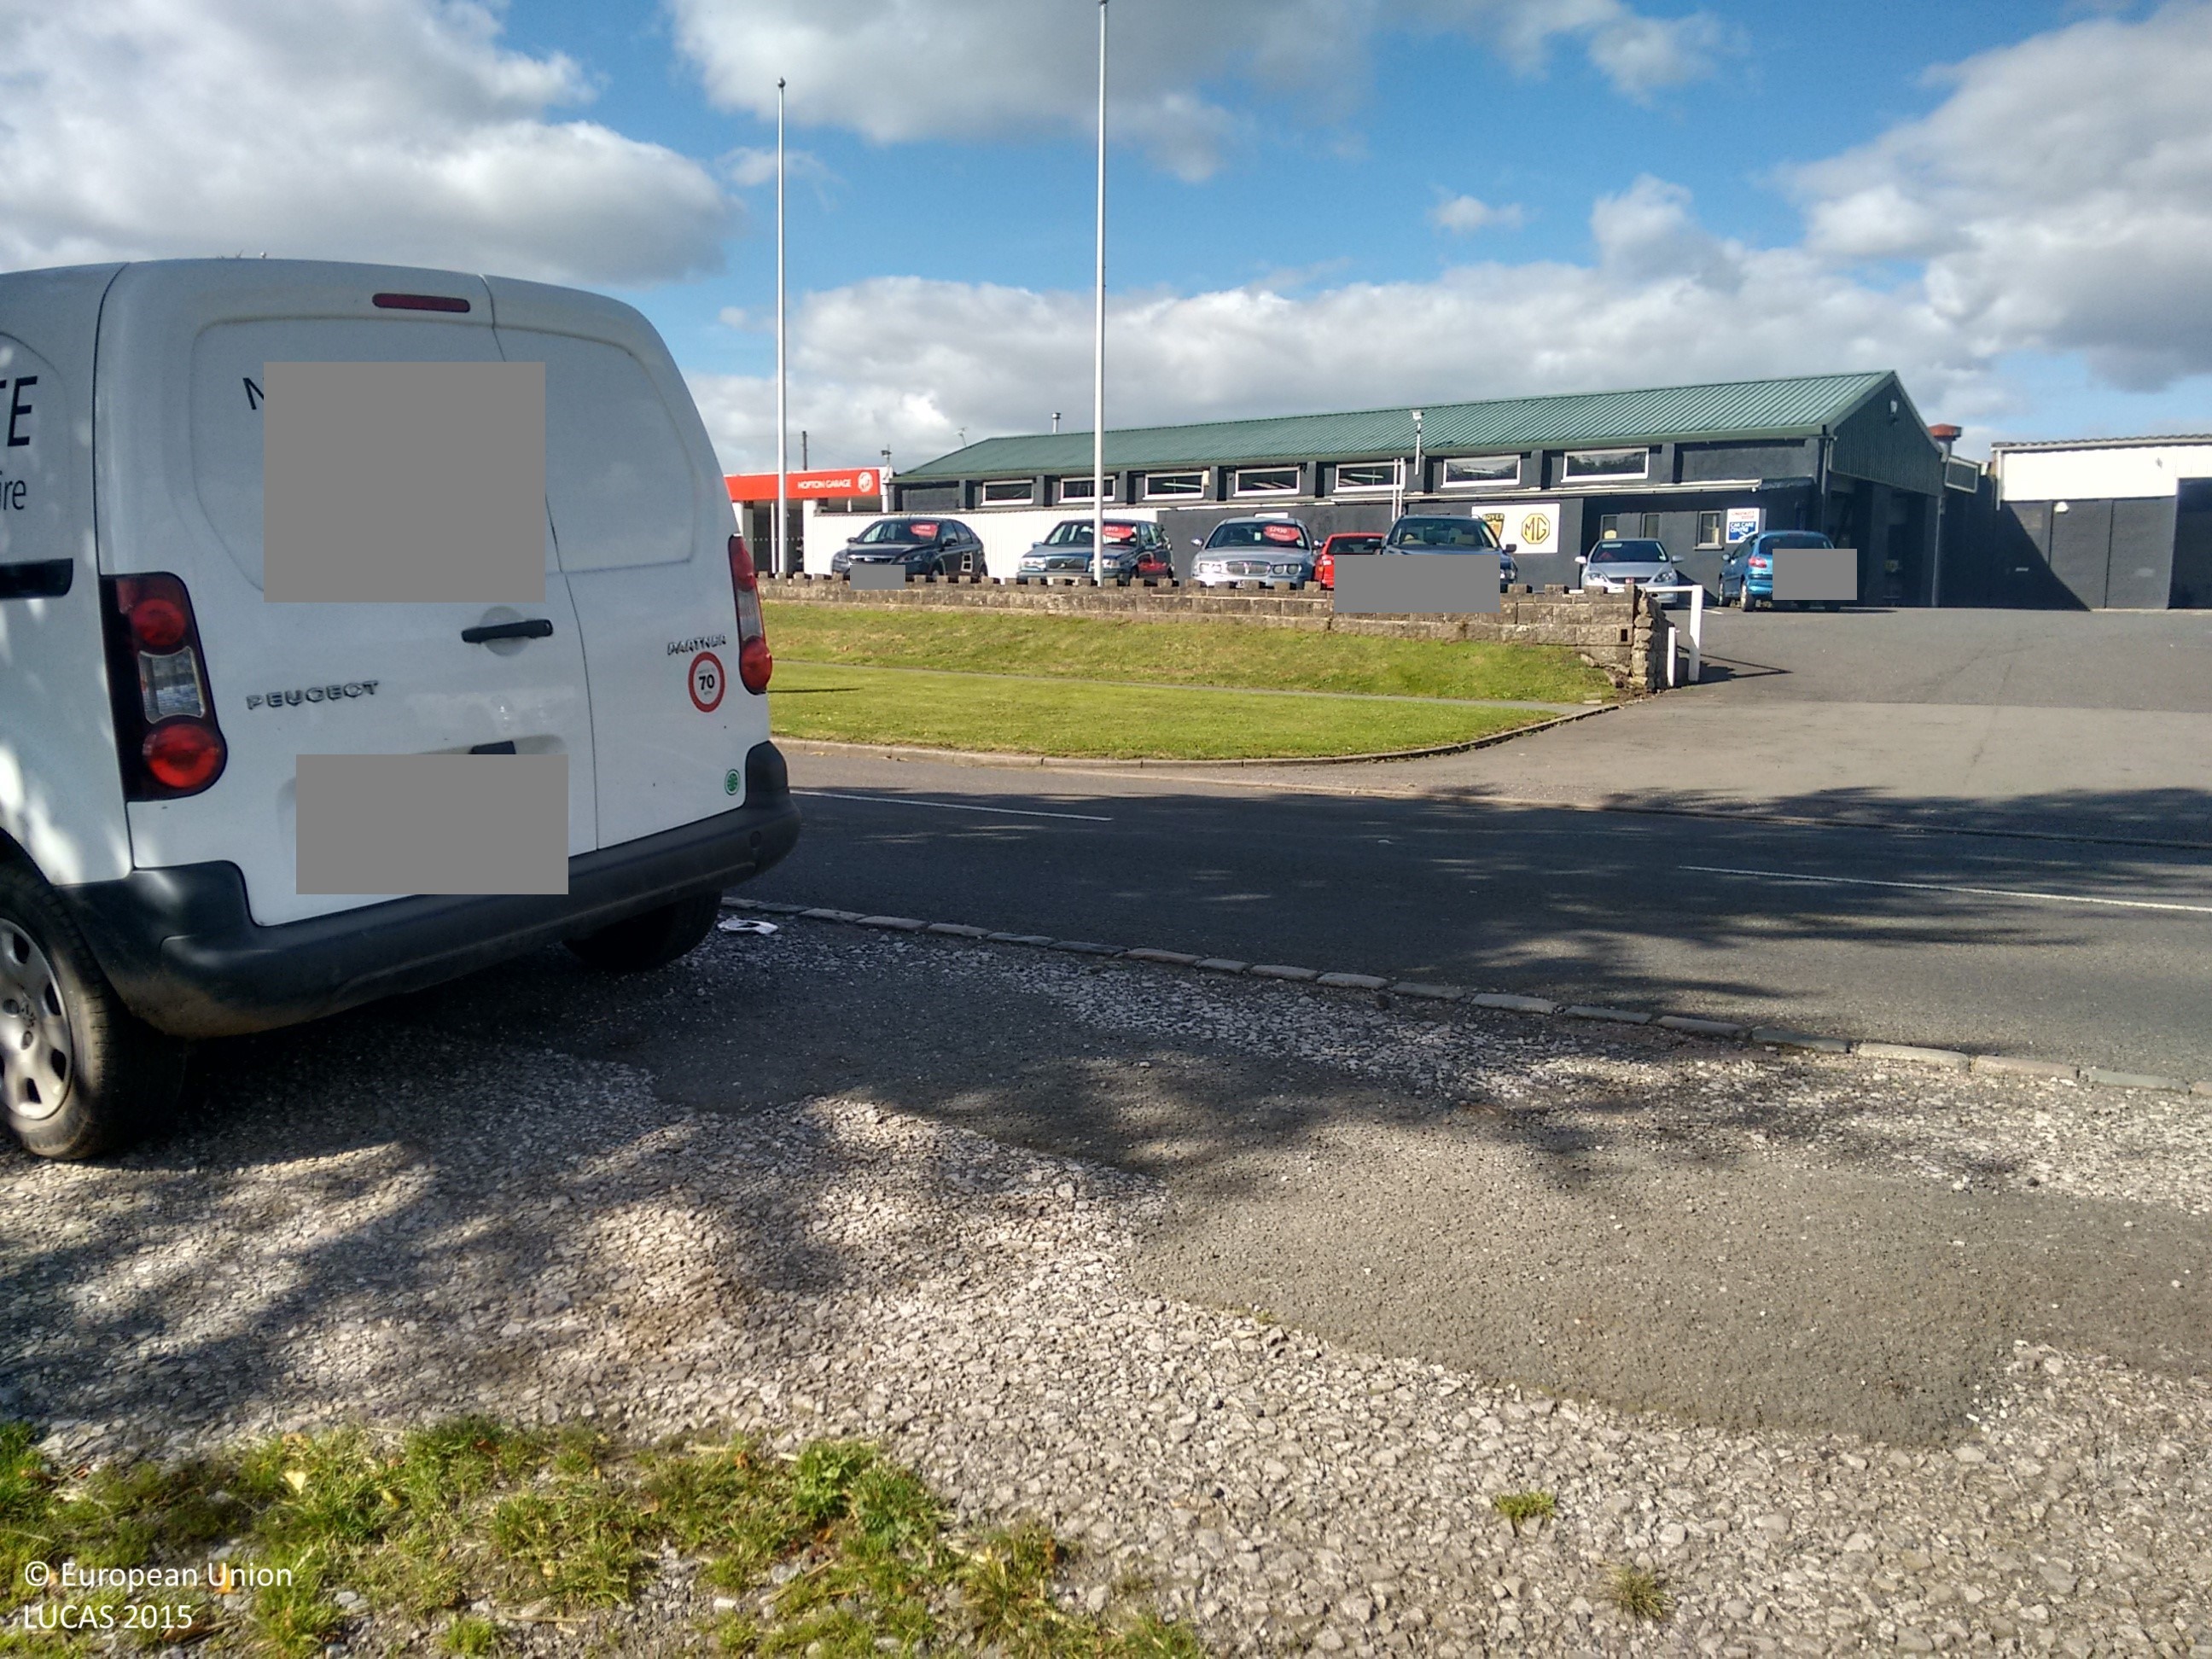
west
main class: Grassland
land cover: Grassland without tree/shrub cover
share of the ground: > 75 %
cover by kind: herbaceous plants 100 %
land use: Agriculture (excluding fallow land and kitchen gardens)
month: September
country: GB
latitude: 52.8292
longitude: -2.0965
